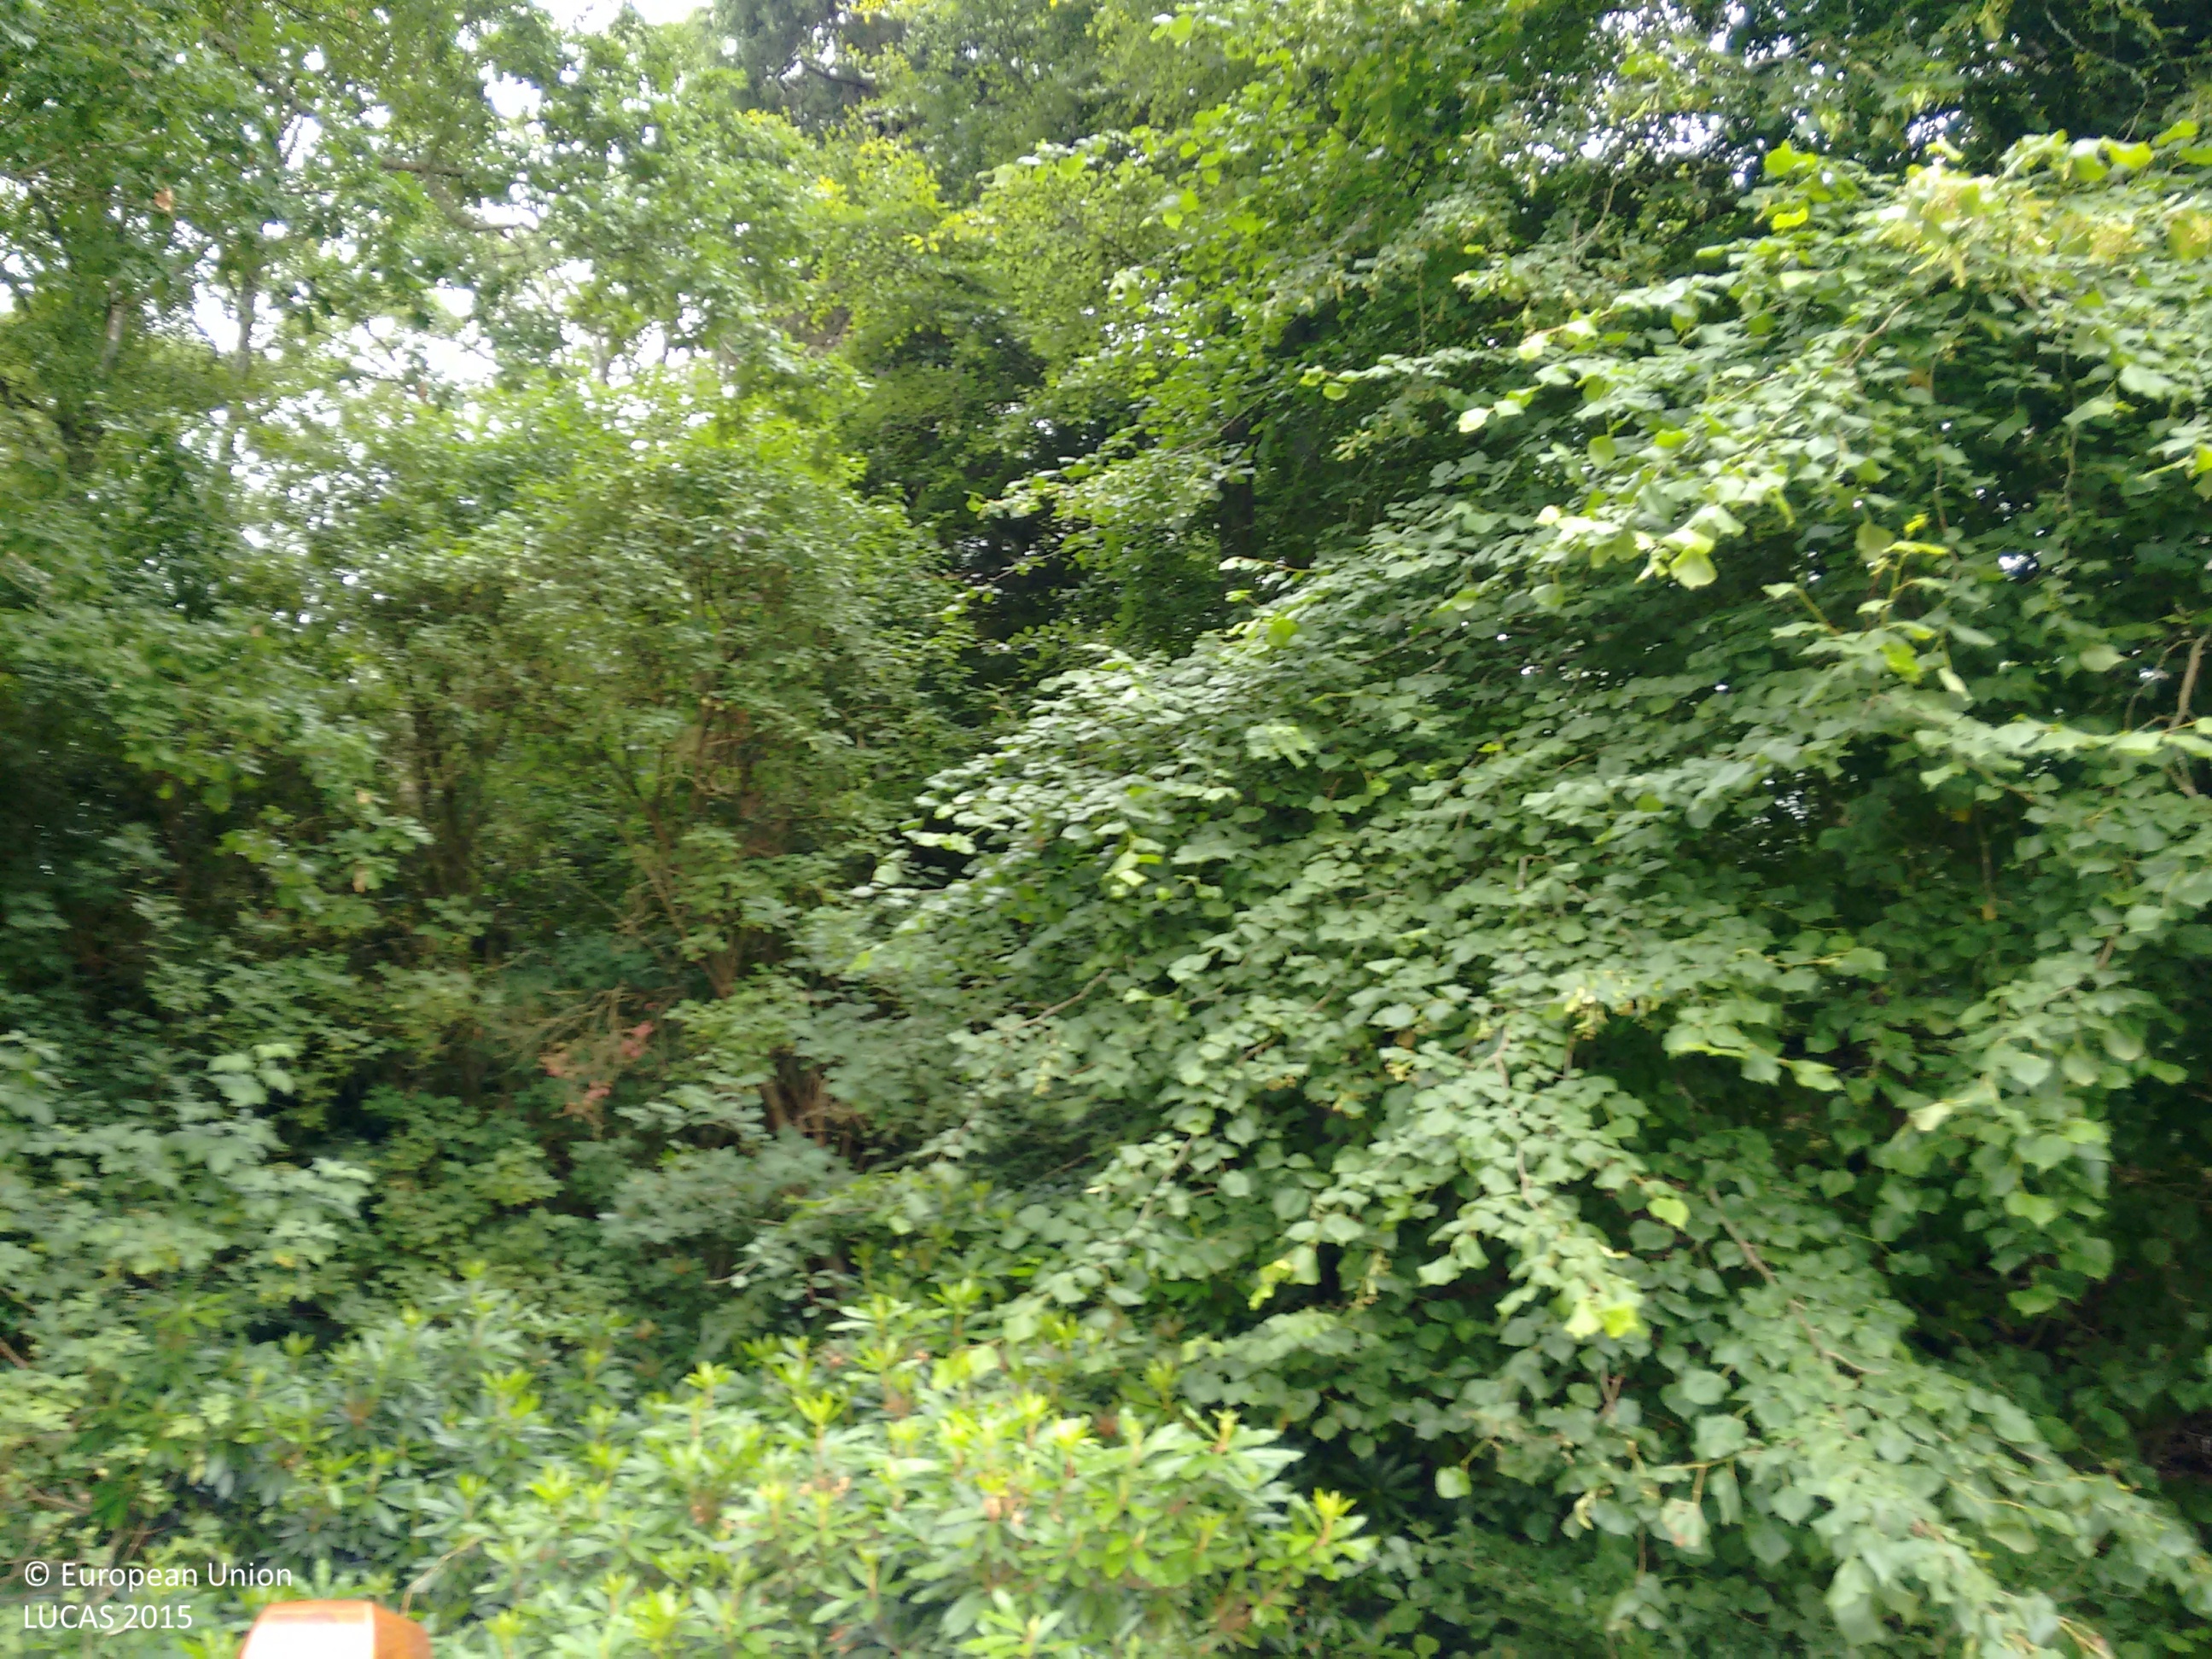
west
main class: Cropland
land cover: Rape and turnip rape
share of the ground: > 75 %
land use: Agriculture (excluding fallow land and kitchen gardens)
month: August
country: GB
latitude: 57.4661
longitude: -4.4785
